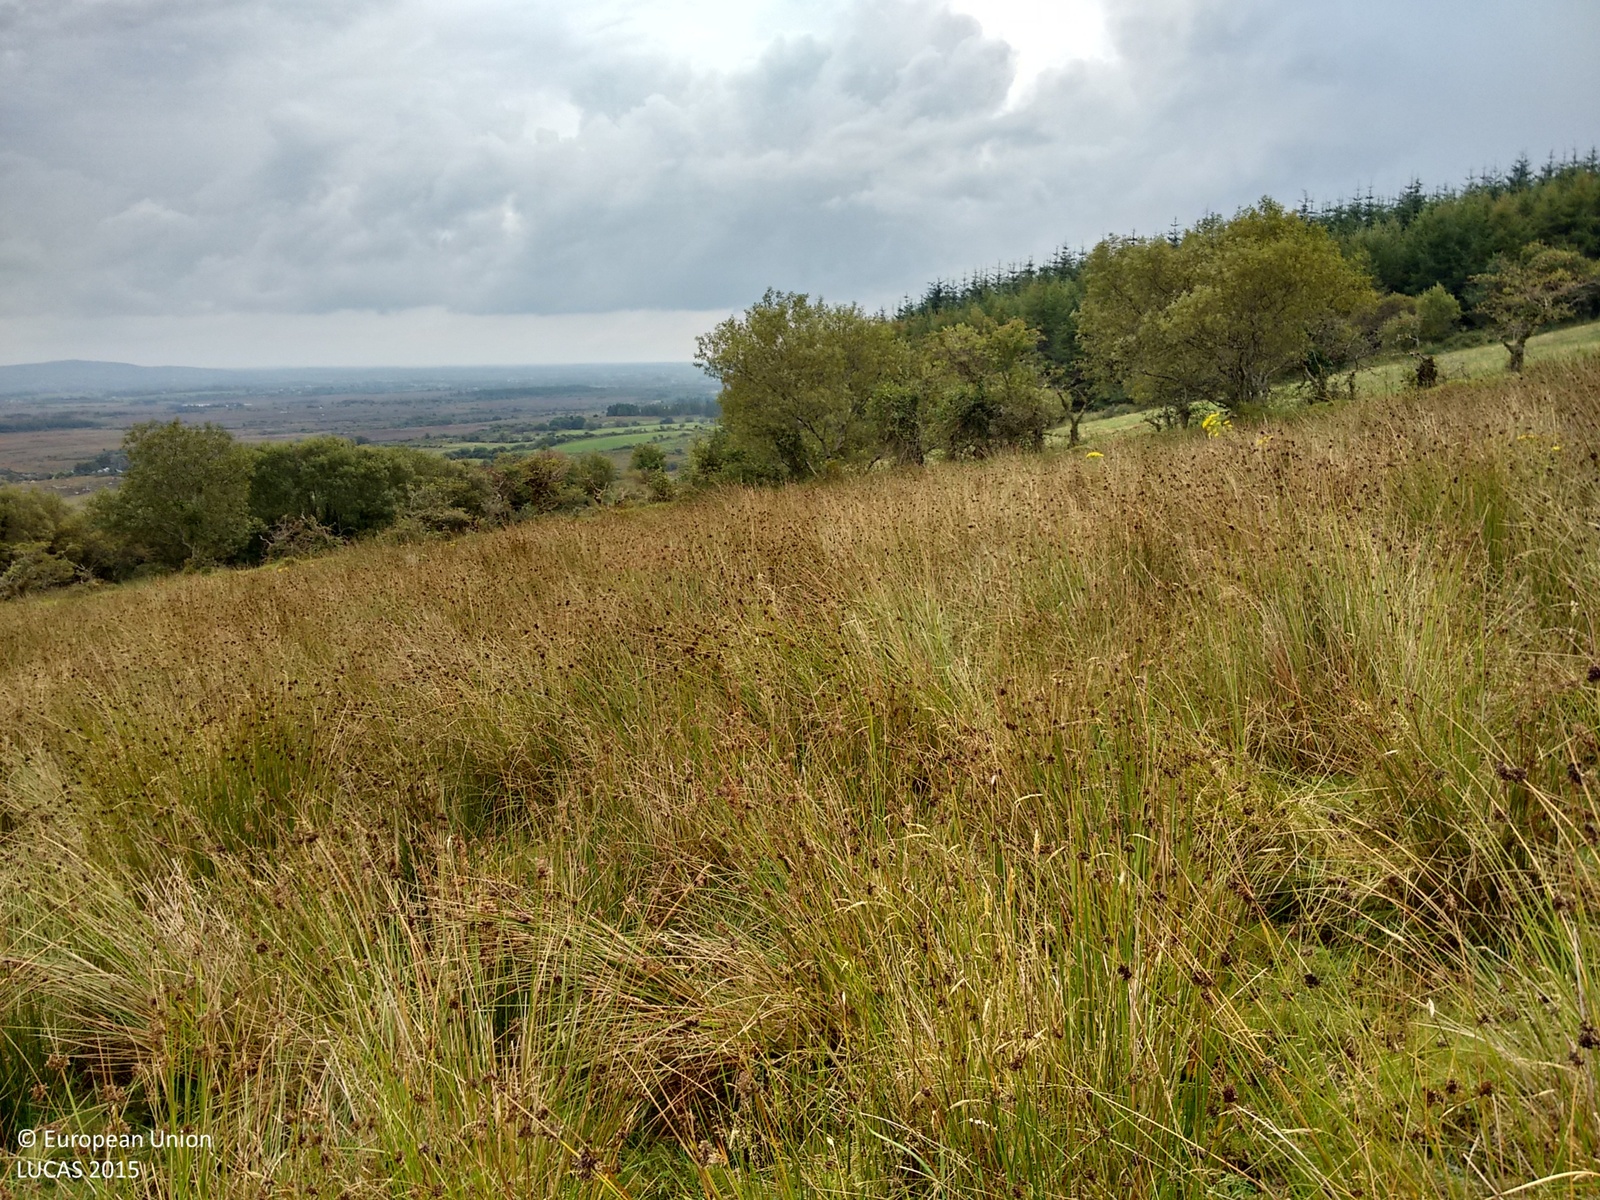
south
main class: Grassland
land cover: Grassland with sparse tree/shrub cover
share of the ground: > 75 %
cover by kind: herbaceous plants 85 %, shrubs 10 %, broadleaved forest trees 5 %
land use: Agriculture (excluding fallow land and kitchen gardens)
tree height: < 5 m
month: September
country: IE
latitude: 53.9250
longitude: -9.2731
